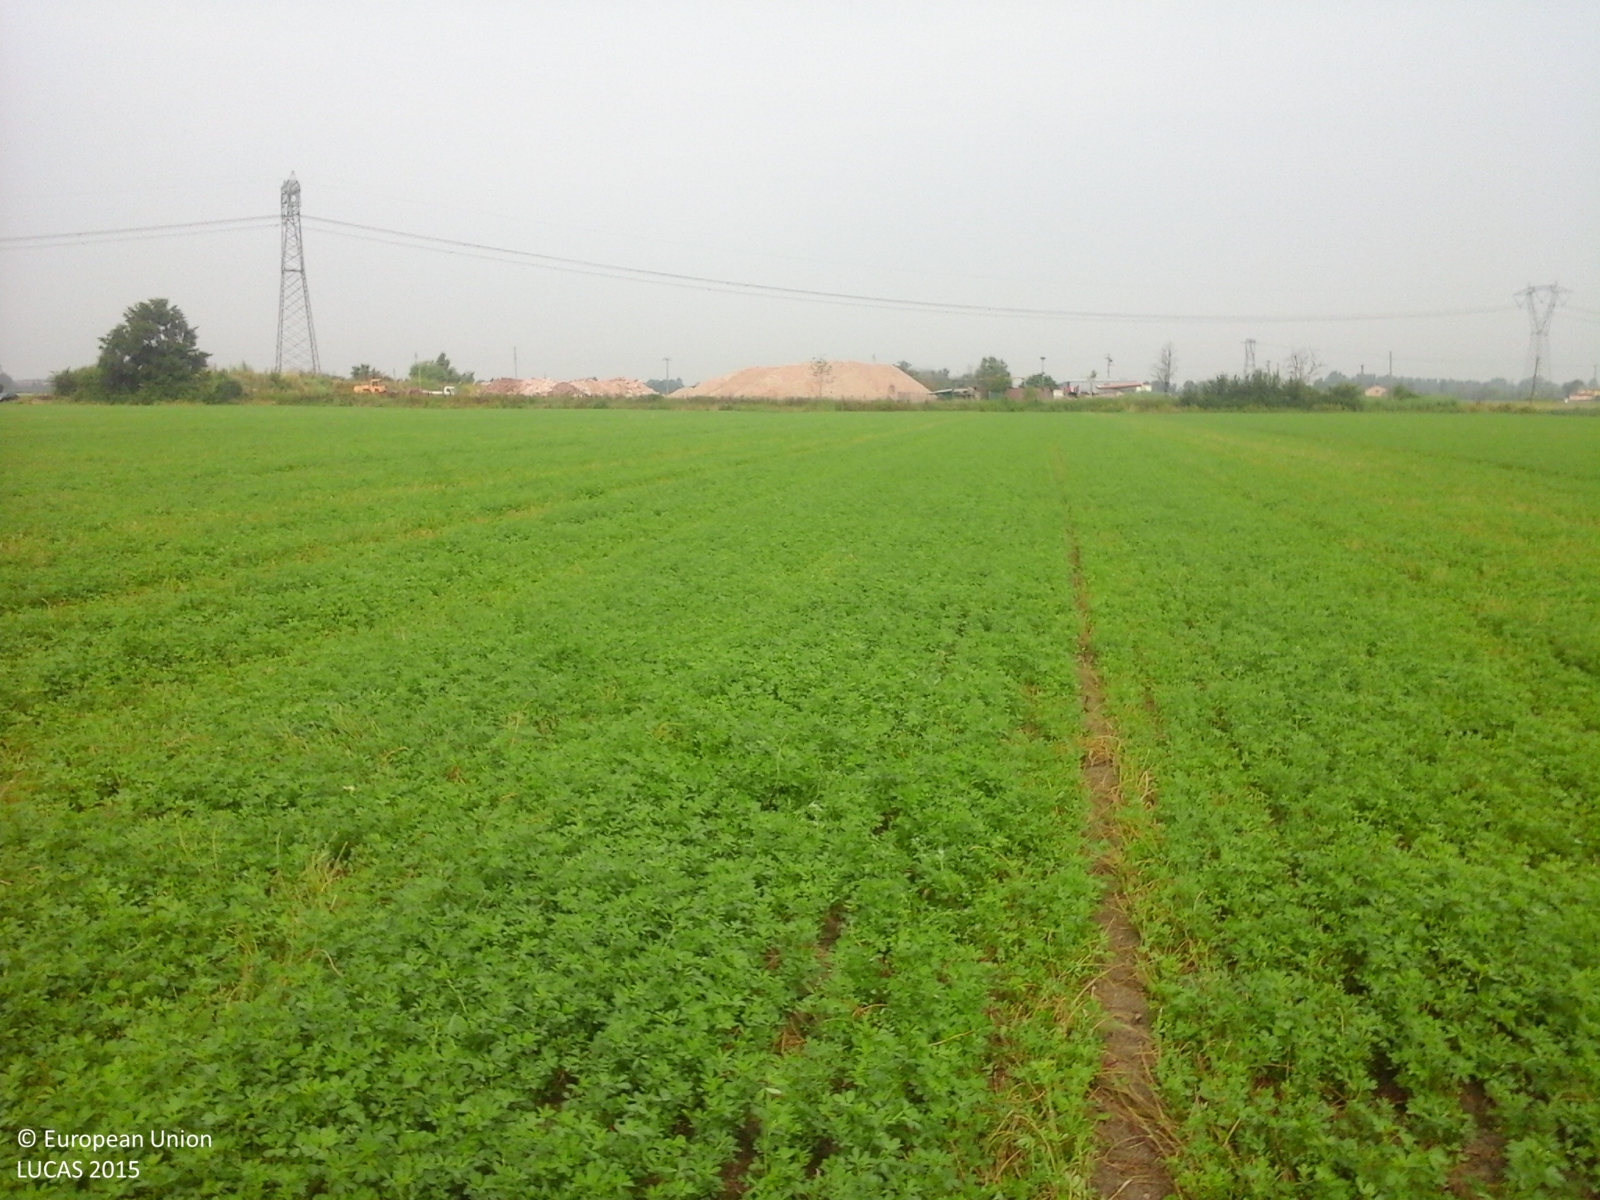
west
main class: Cropland
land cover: Lucerne
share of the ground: > 75 %
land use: Agriculture (excluding fallow land and kitchen gardens)
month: June
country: IT
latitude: 44.6885
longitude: 10.9947
